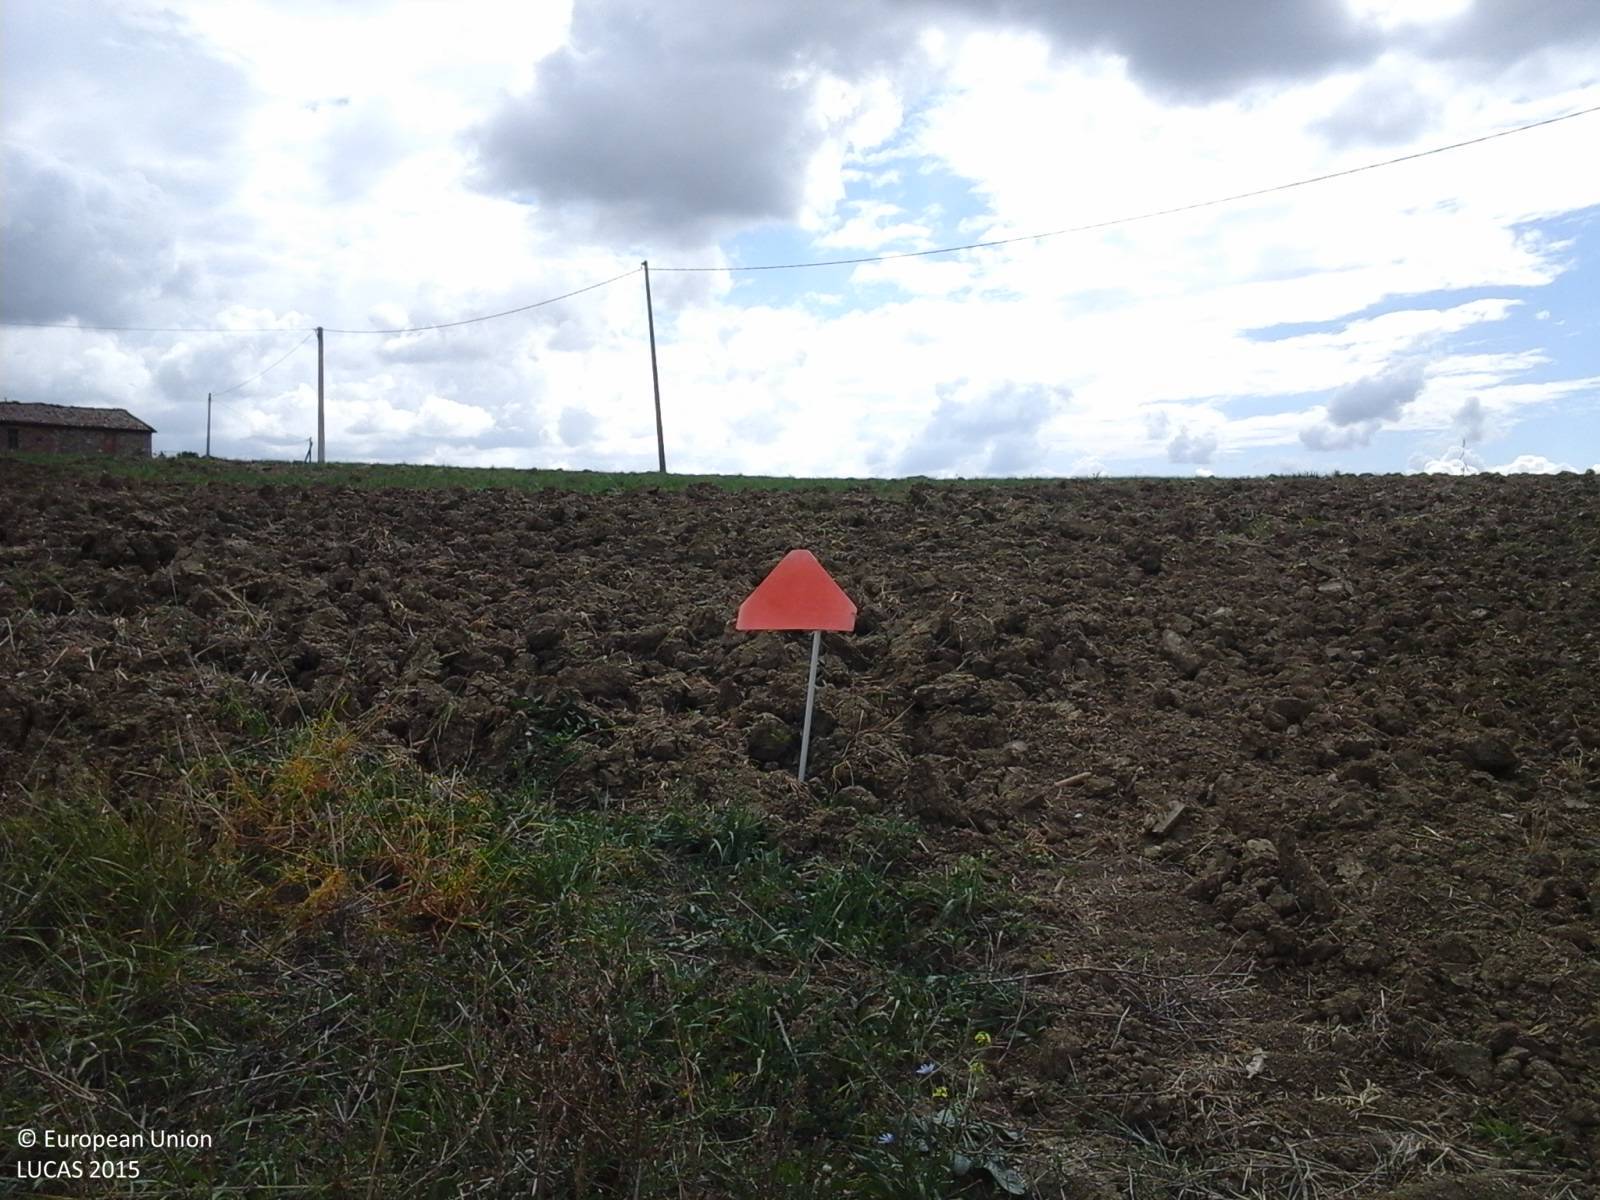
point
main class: Cropland
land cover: Barley
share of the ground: < 10 %
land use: Agriculture (excluding fallow land and kitchen gardens)
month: September
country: IT
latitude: 42.9343
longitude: 12.3334
